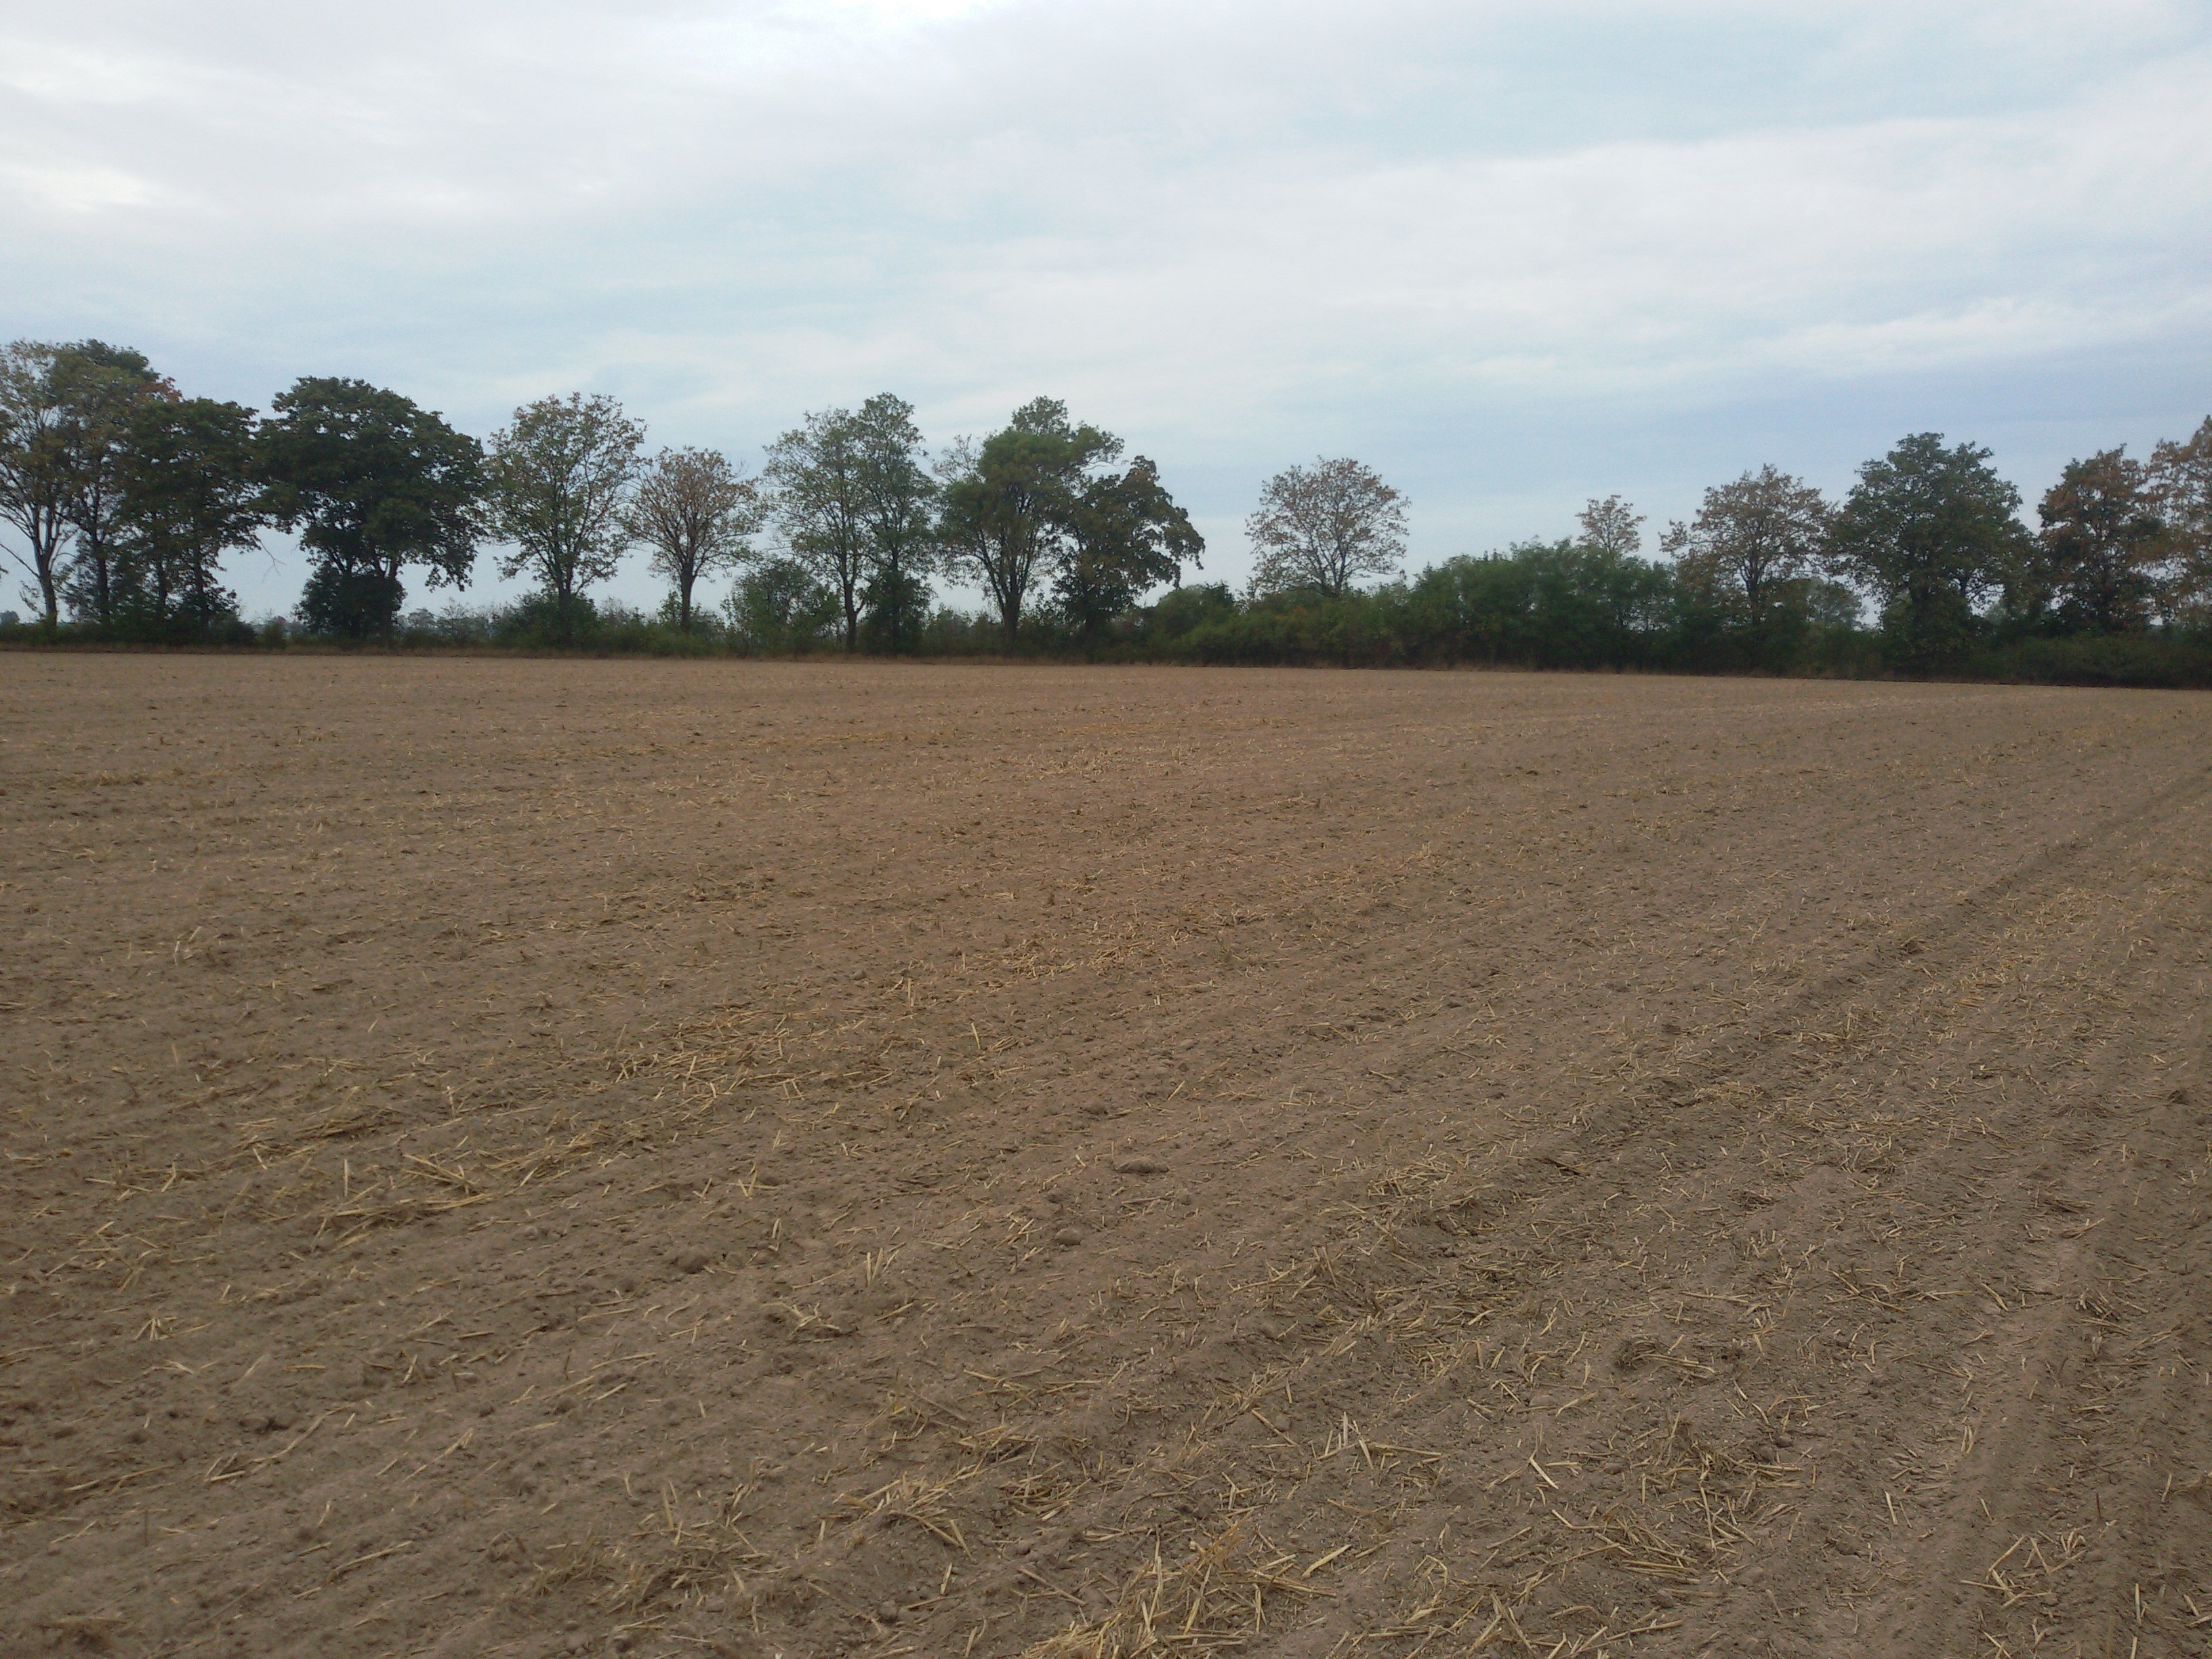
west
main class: Cropland
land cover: Common wheat
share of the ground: < 10 %
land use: Agriculture (excluding fallow land and kitchen gardens)
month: August
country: PL
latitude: 51.7718
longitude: 17.8843
